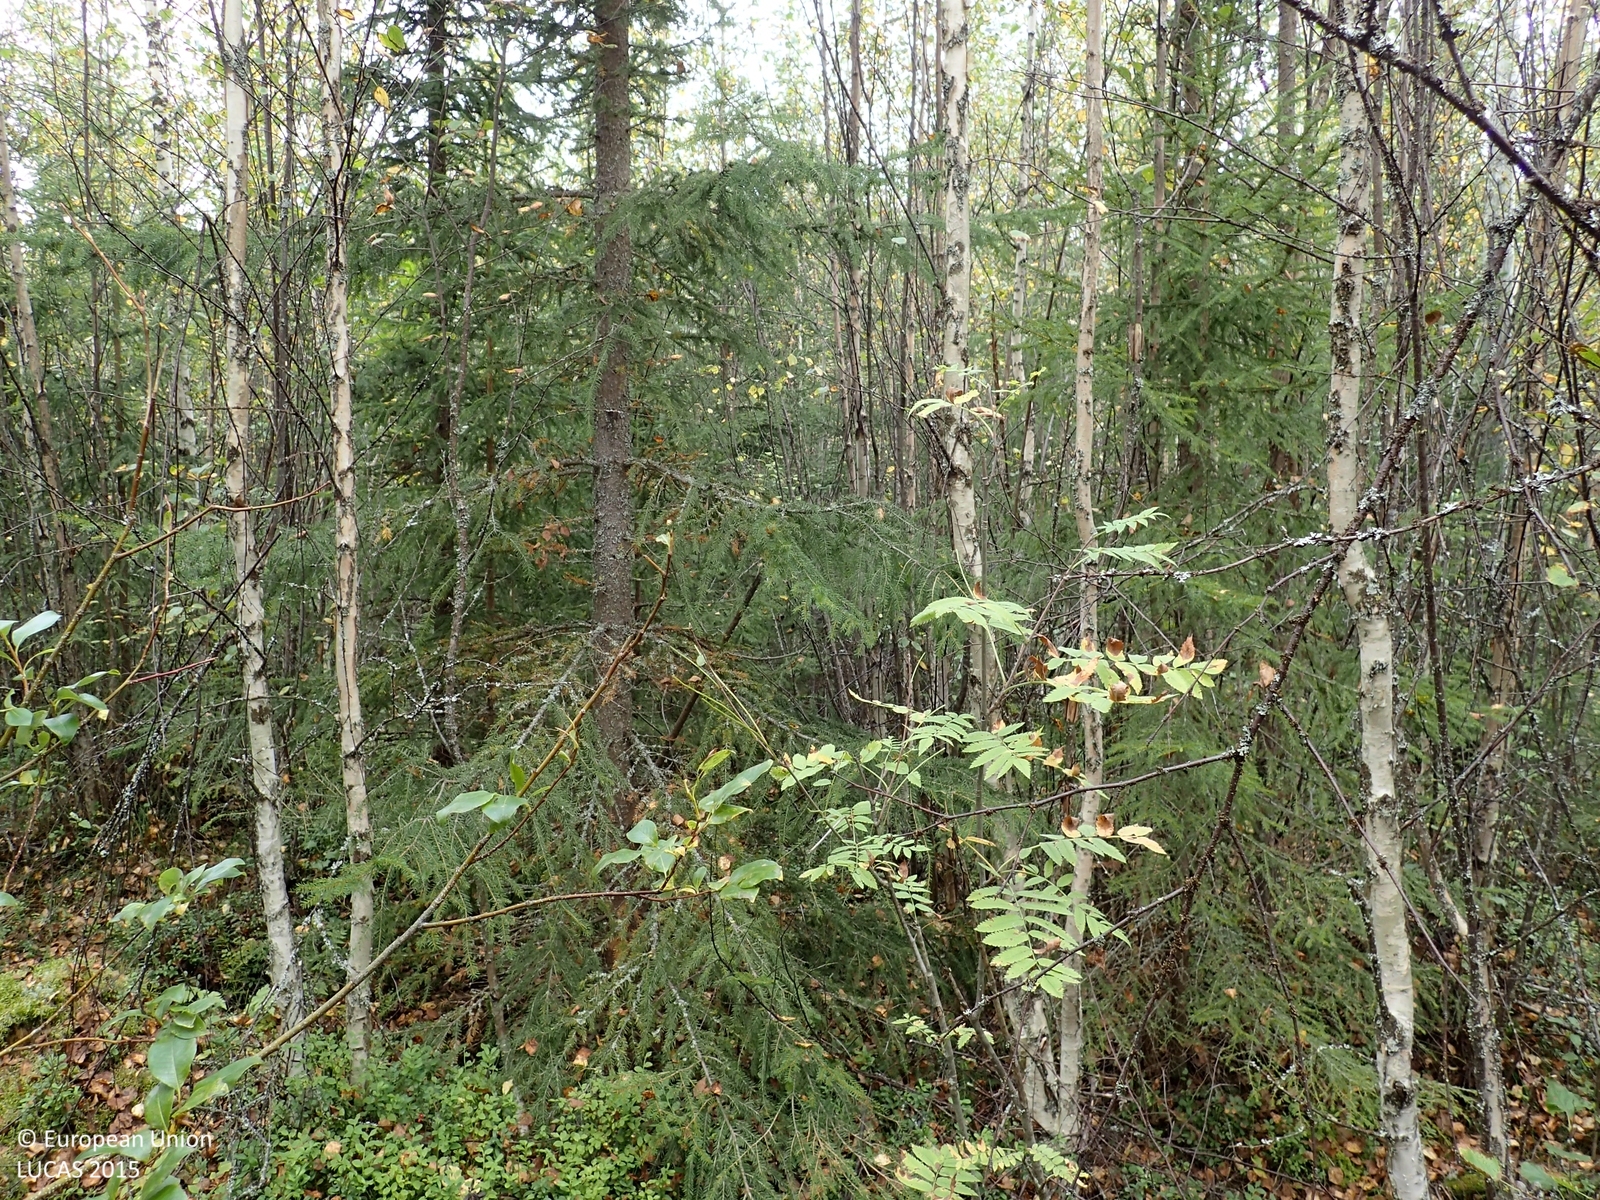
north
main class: Woodland
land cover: Spruce dominated mixed woodland
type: boreal forest
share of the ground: > 75 %
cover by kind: broadleaved forest trees 50 %, coniferous forest trees 35 %, shrubs 5 %, herbaceous plants 5 %, lichens and mosses 5 %
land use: Forestry
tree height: < 5 m
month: September
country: FI
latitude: 62.9199
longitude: 25.9289
